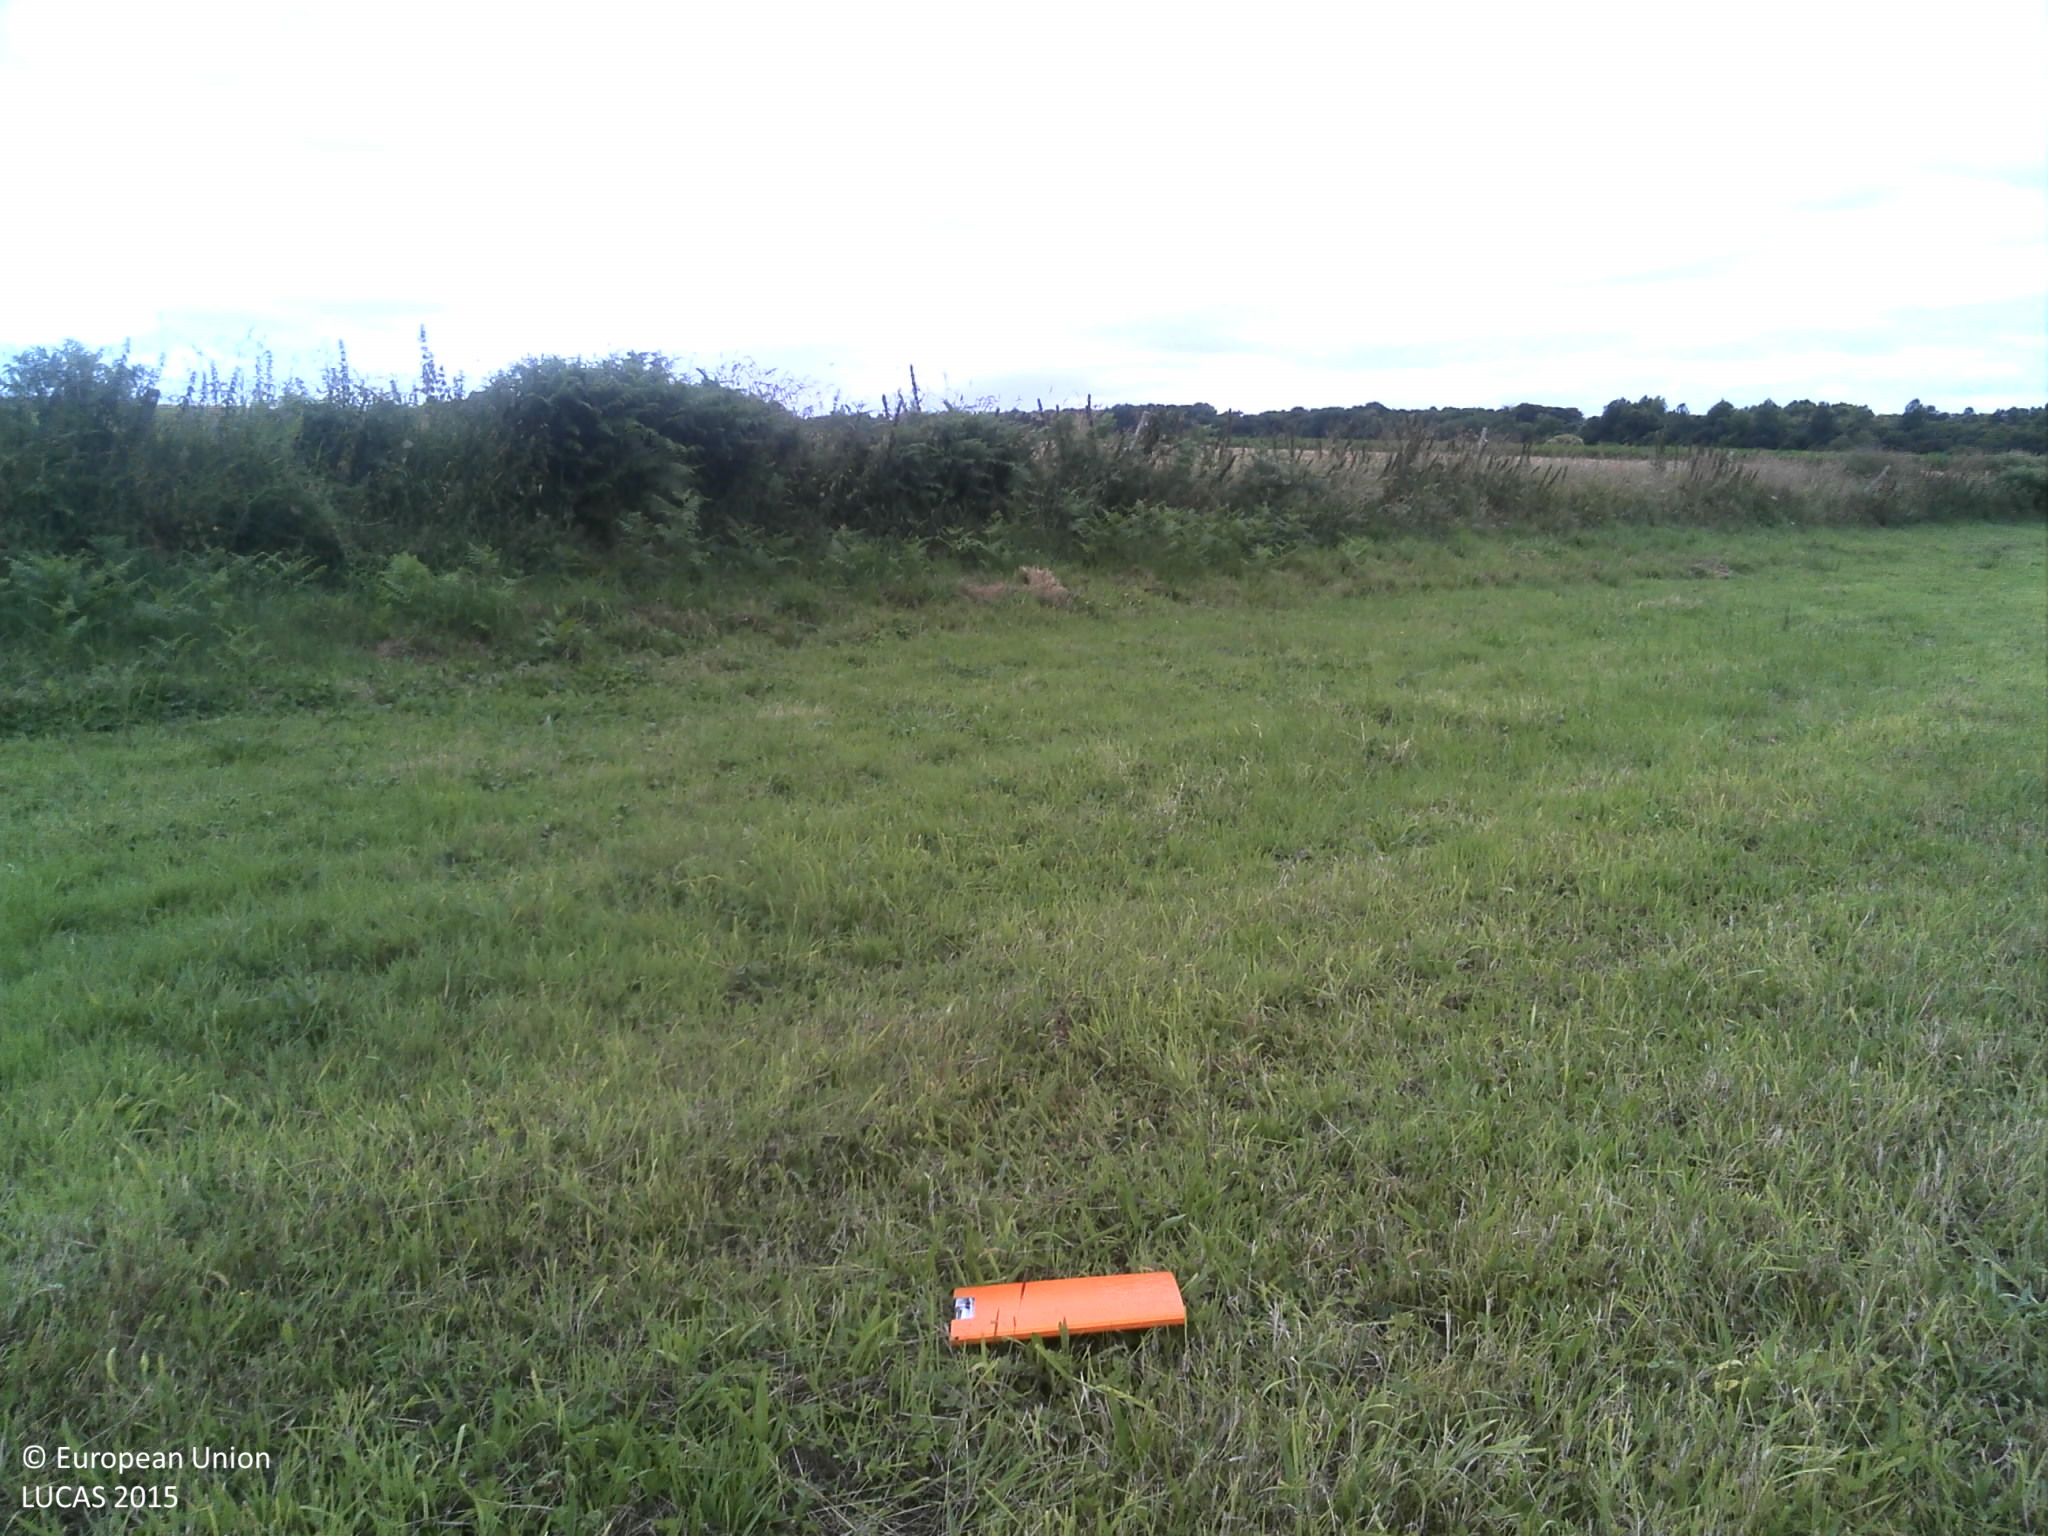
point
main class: Grassland
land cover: Grassland without tree/shrub cover
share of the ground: > 75 %
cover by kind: herbaceous plants 100 %
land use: Agriculture (excluding fallow land and kitchen gardens)
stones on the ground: < 10 %
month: July
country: FR
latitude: 48.5816
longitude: -3.7341
